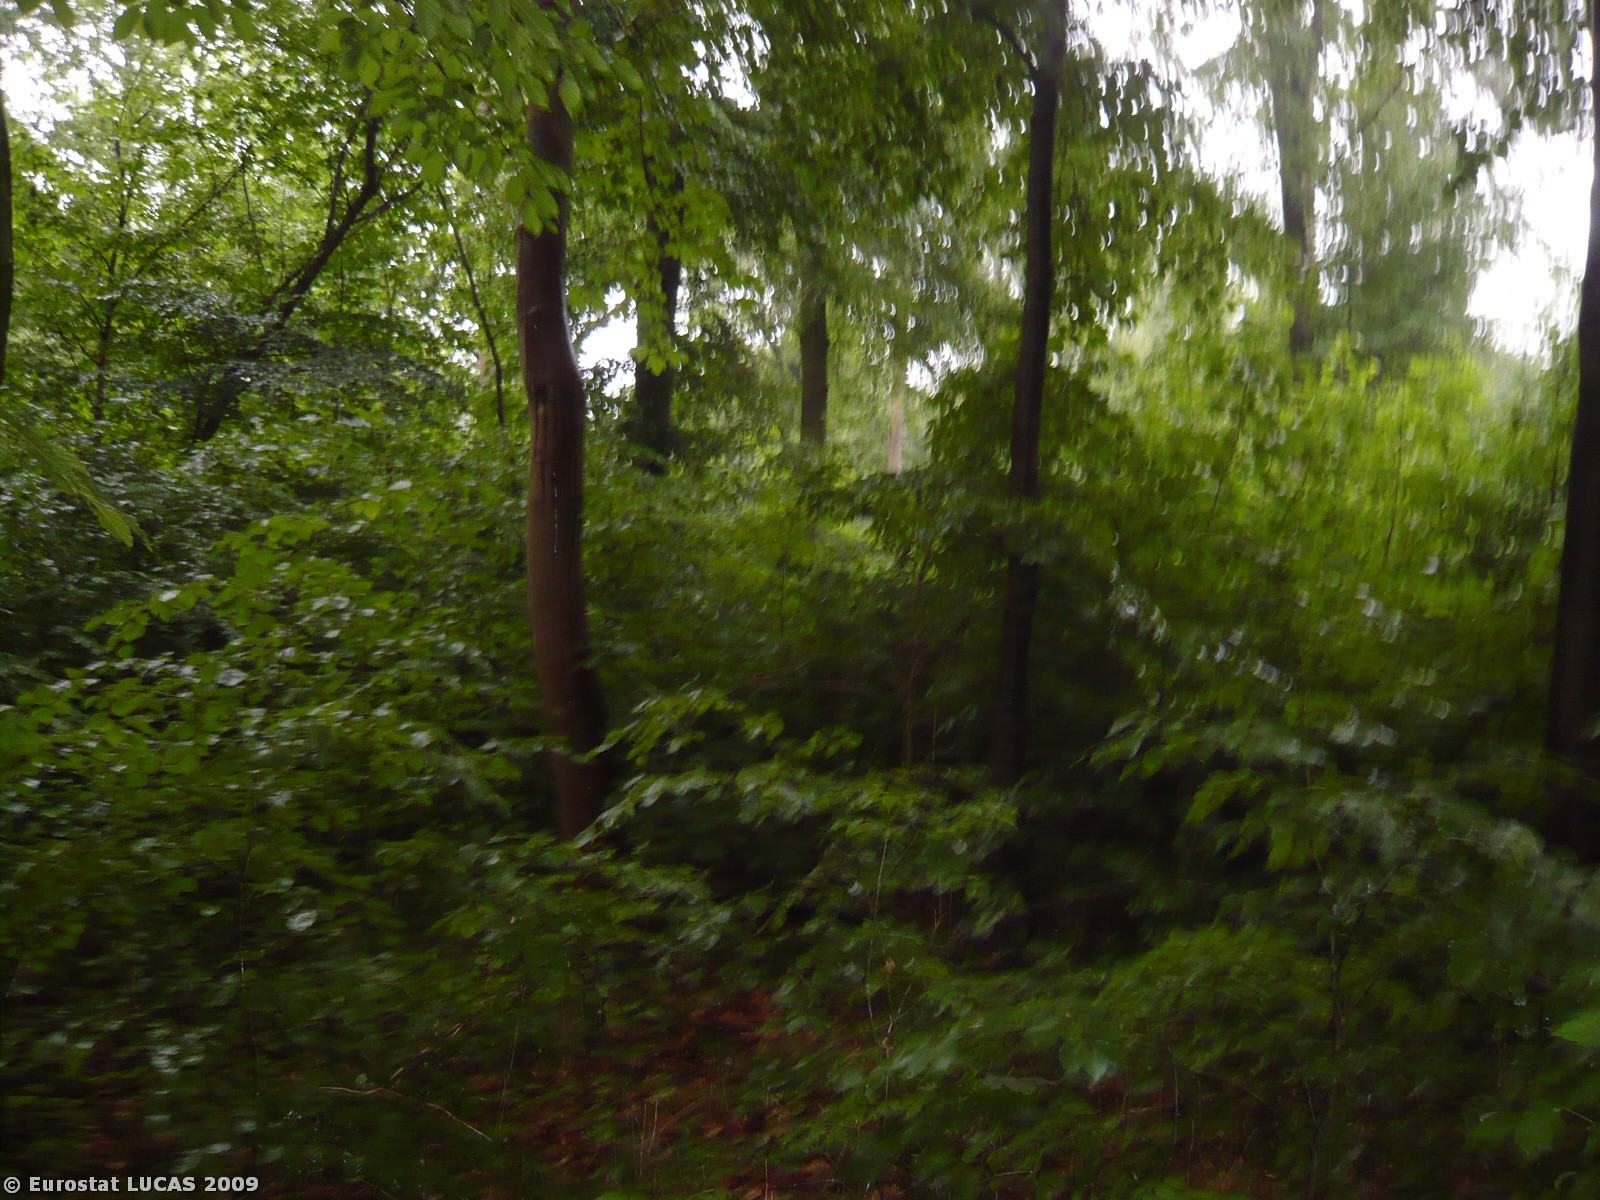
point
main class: Woodland
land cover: Broadleaved woodland
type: mesophytic deciduous forest
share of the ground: > 75 %
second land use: Amenities, museums, leisure
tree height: > 5 m
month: June
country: DK
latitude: 54.7914
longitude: 11.7563
